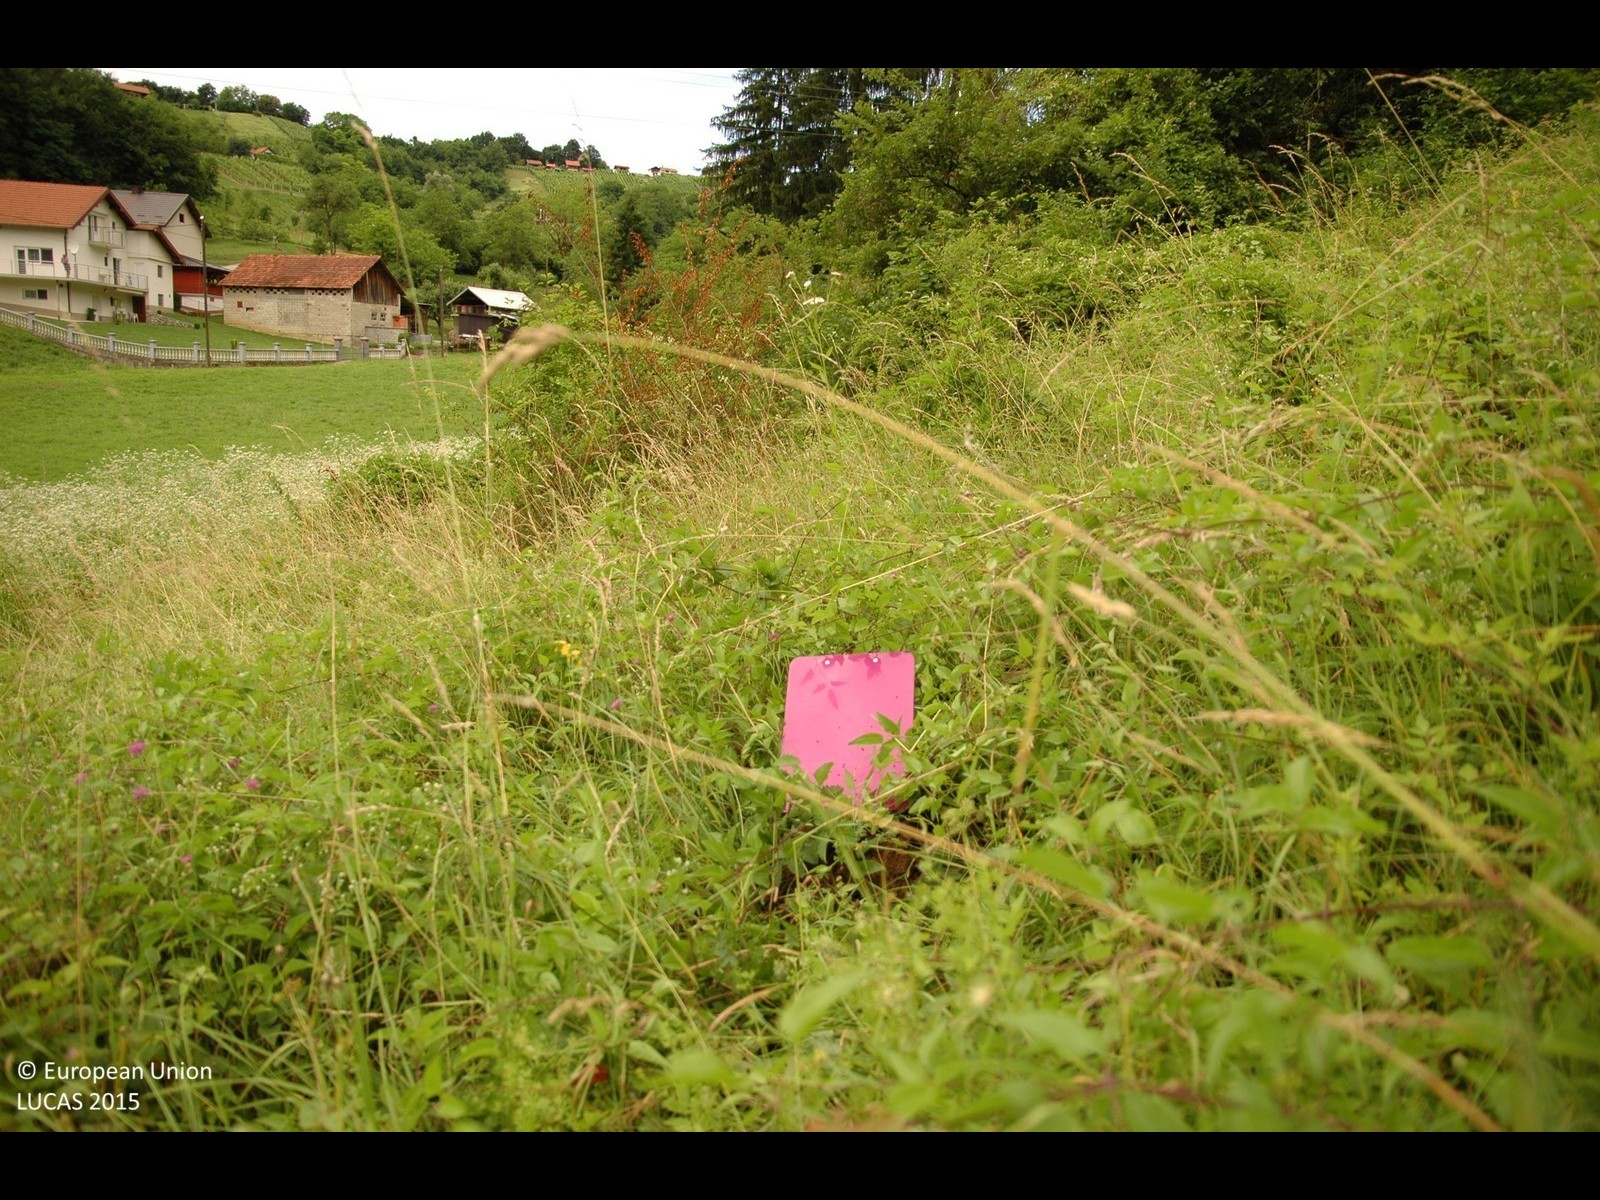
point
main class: Grassland
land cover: Spontaneously vegetated surfaces
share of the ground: > 75 %
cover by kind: herbaceous plants 95 %, shrubs 5 %
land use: Abandoned areas
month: June
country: HR
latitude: 46.0989
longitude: 15.8841
